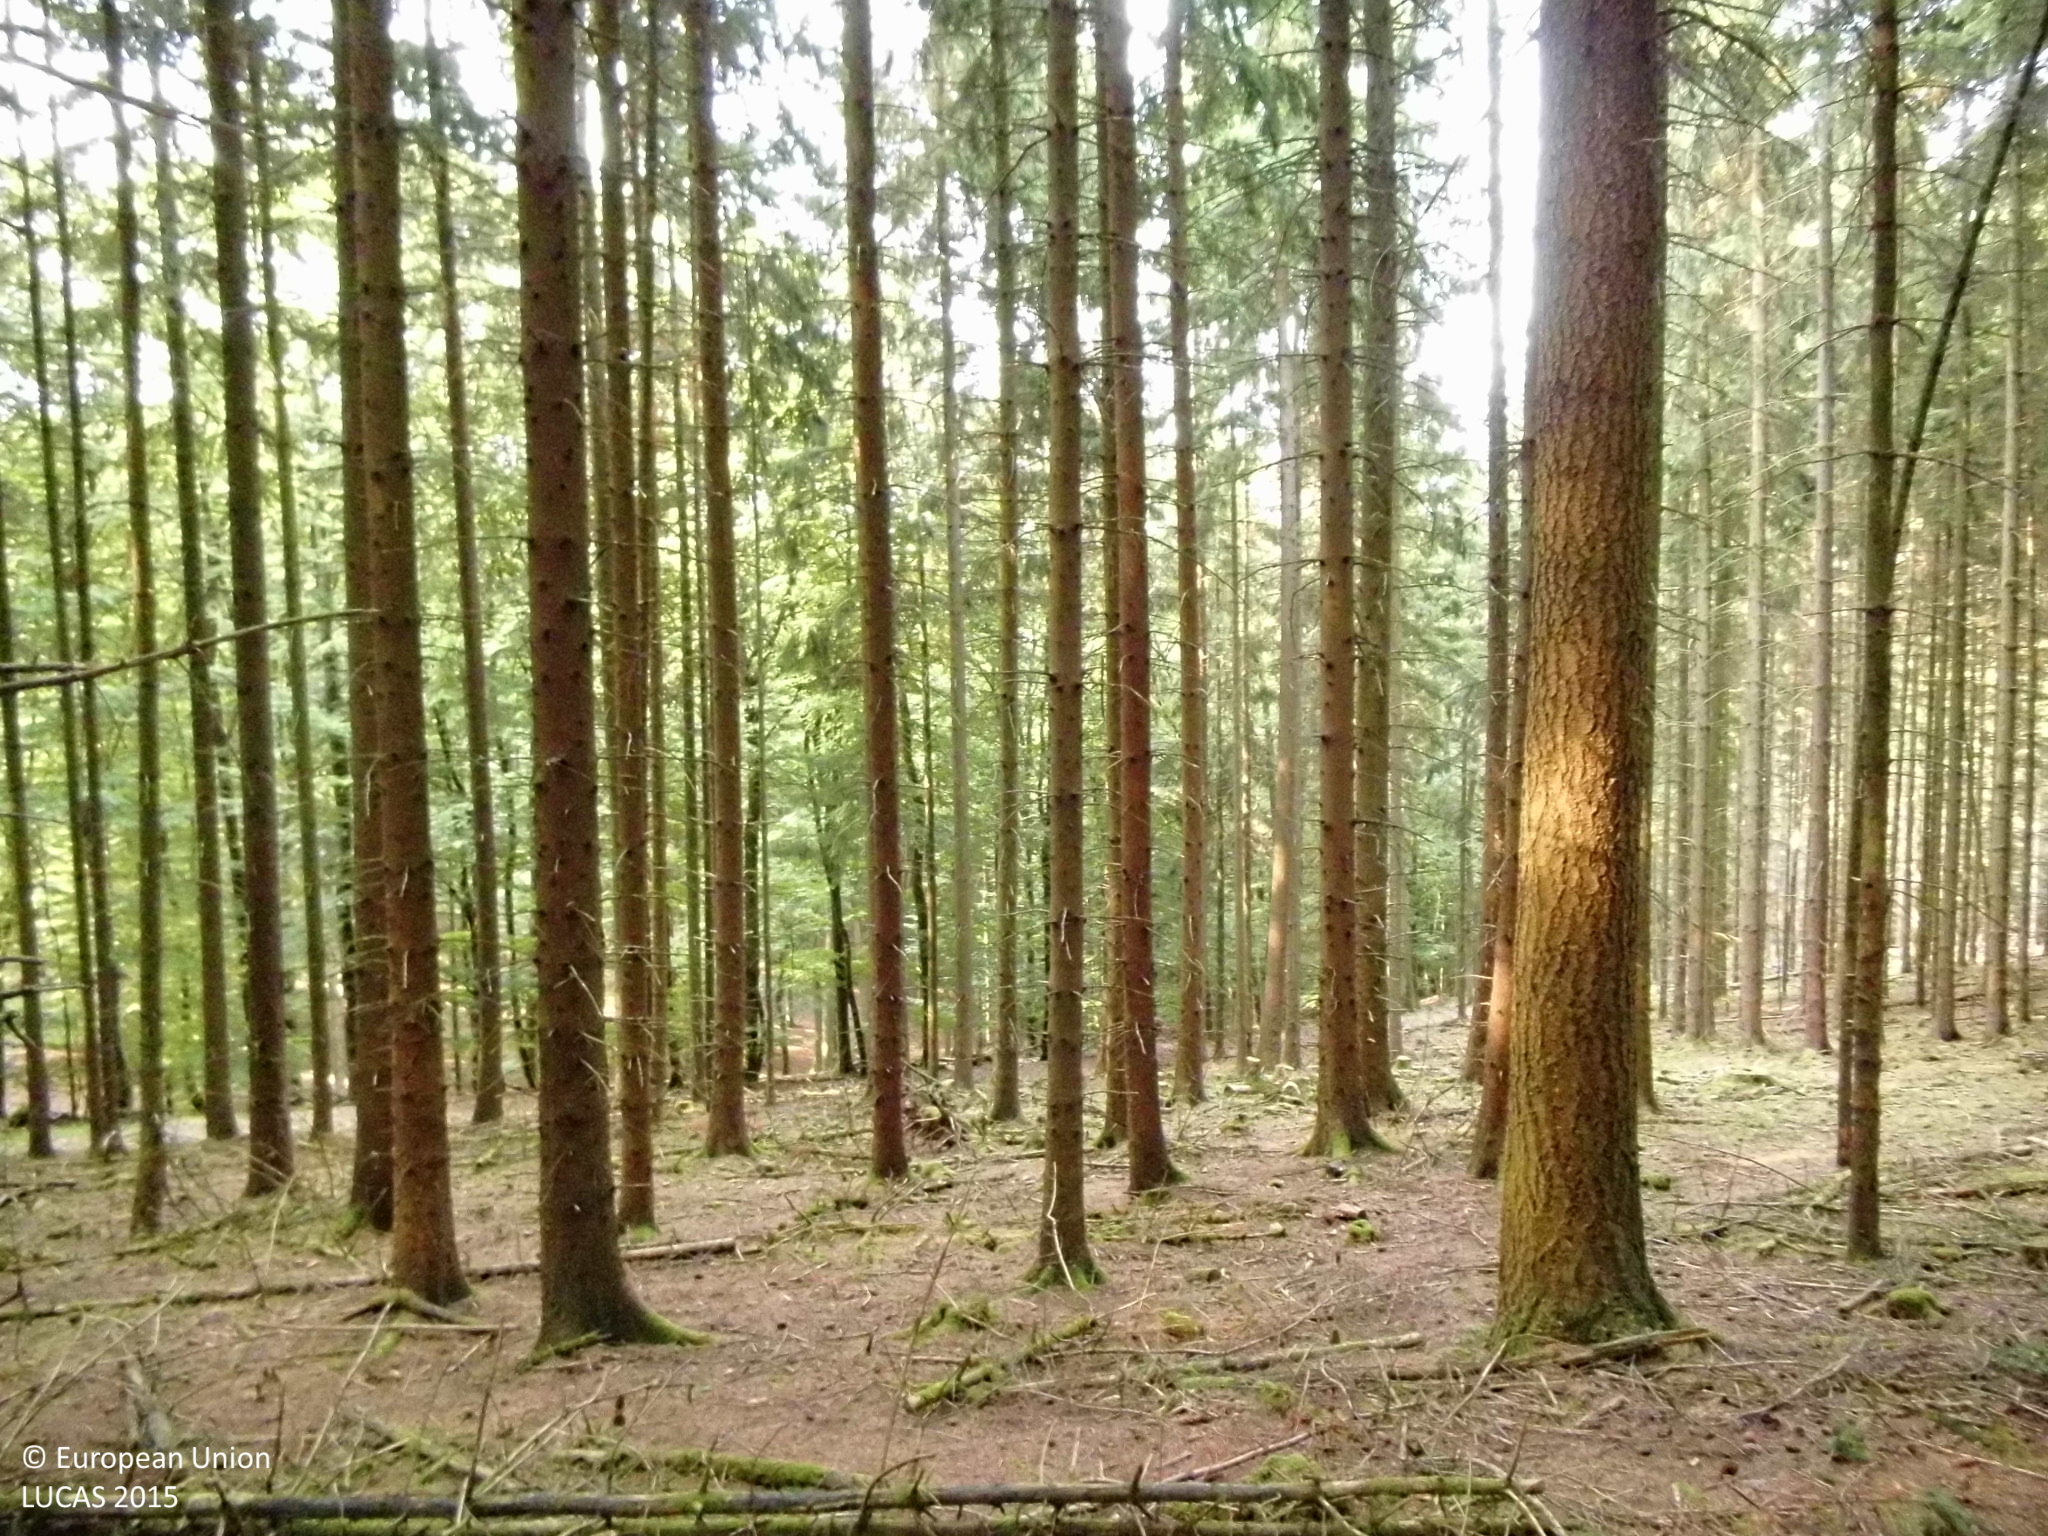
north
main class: Woodland
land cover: Other coniferous woodland
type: hemiboreal forest and nemoral coniferous forest and mixed broadleaved-coniferous forest
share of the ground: > 75 %
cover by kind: coniferous forest trees 90 %, lichens and mosses 5 %, unconsolidated bare surface 5 %
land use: Forestry
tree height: > 5 m
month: August
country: DE
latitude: 50.8230
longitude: 8.5950
